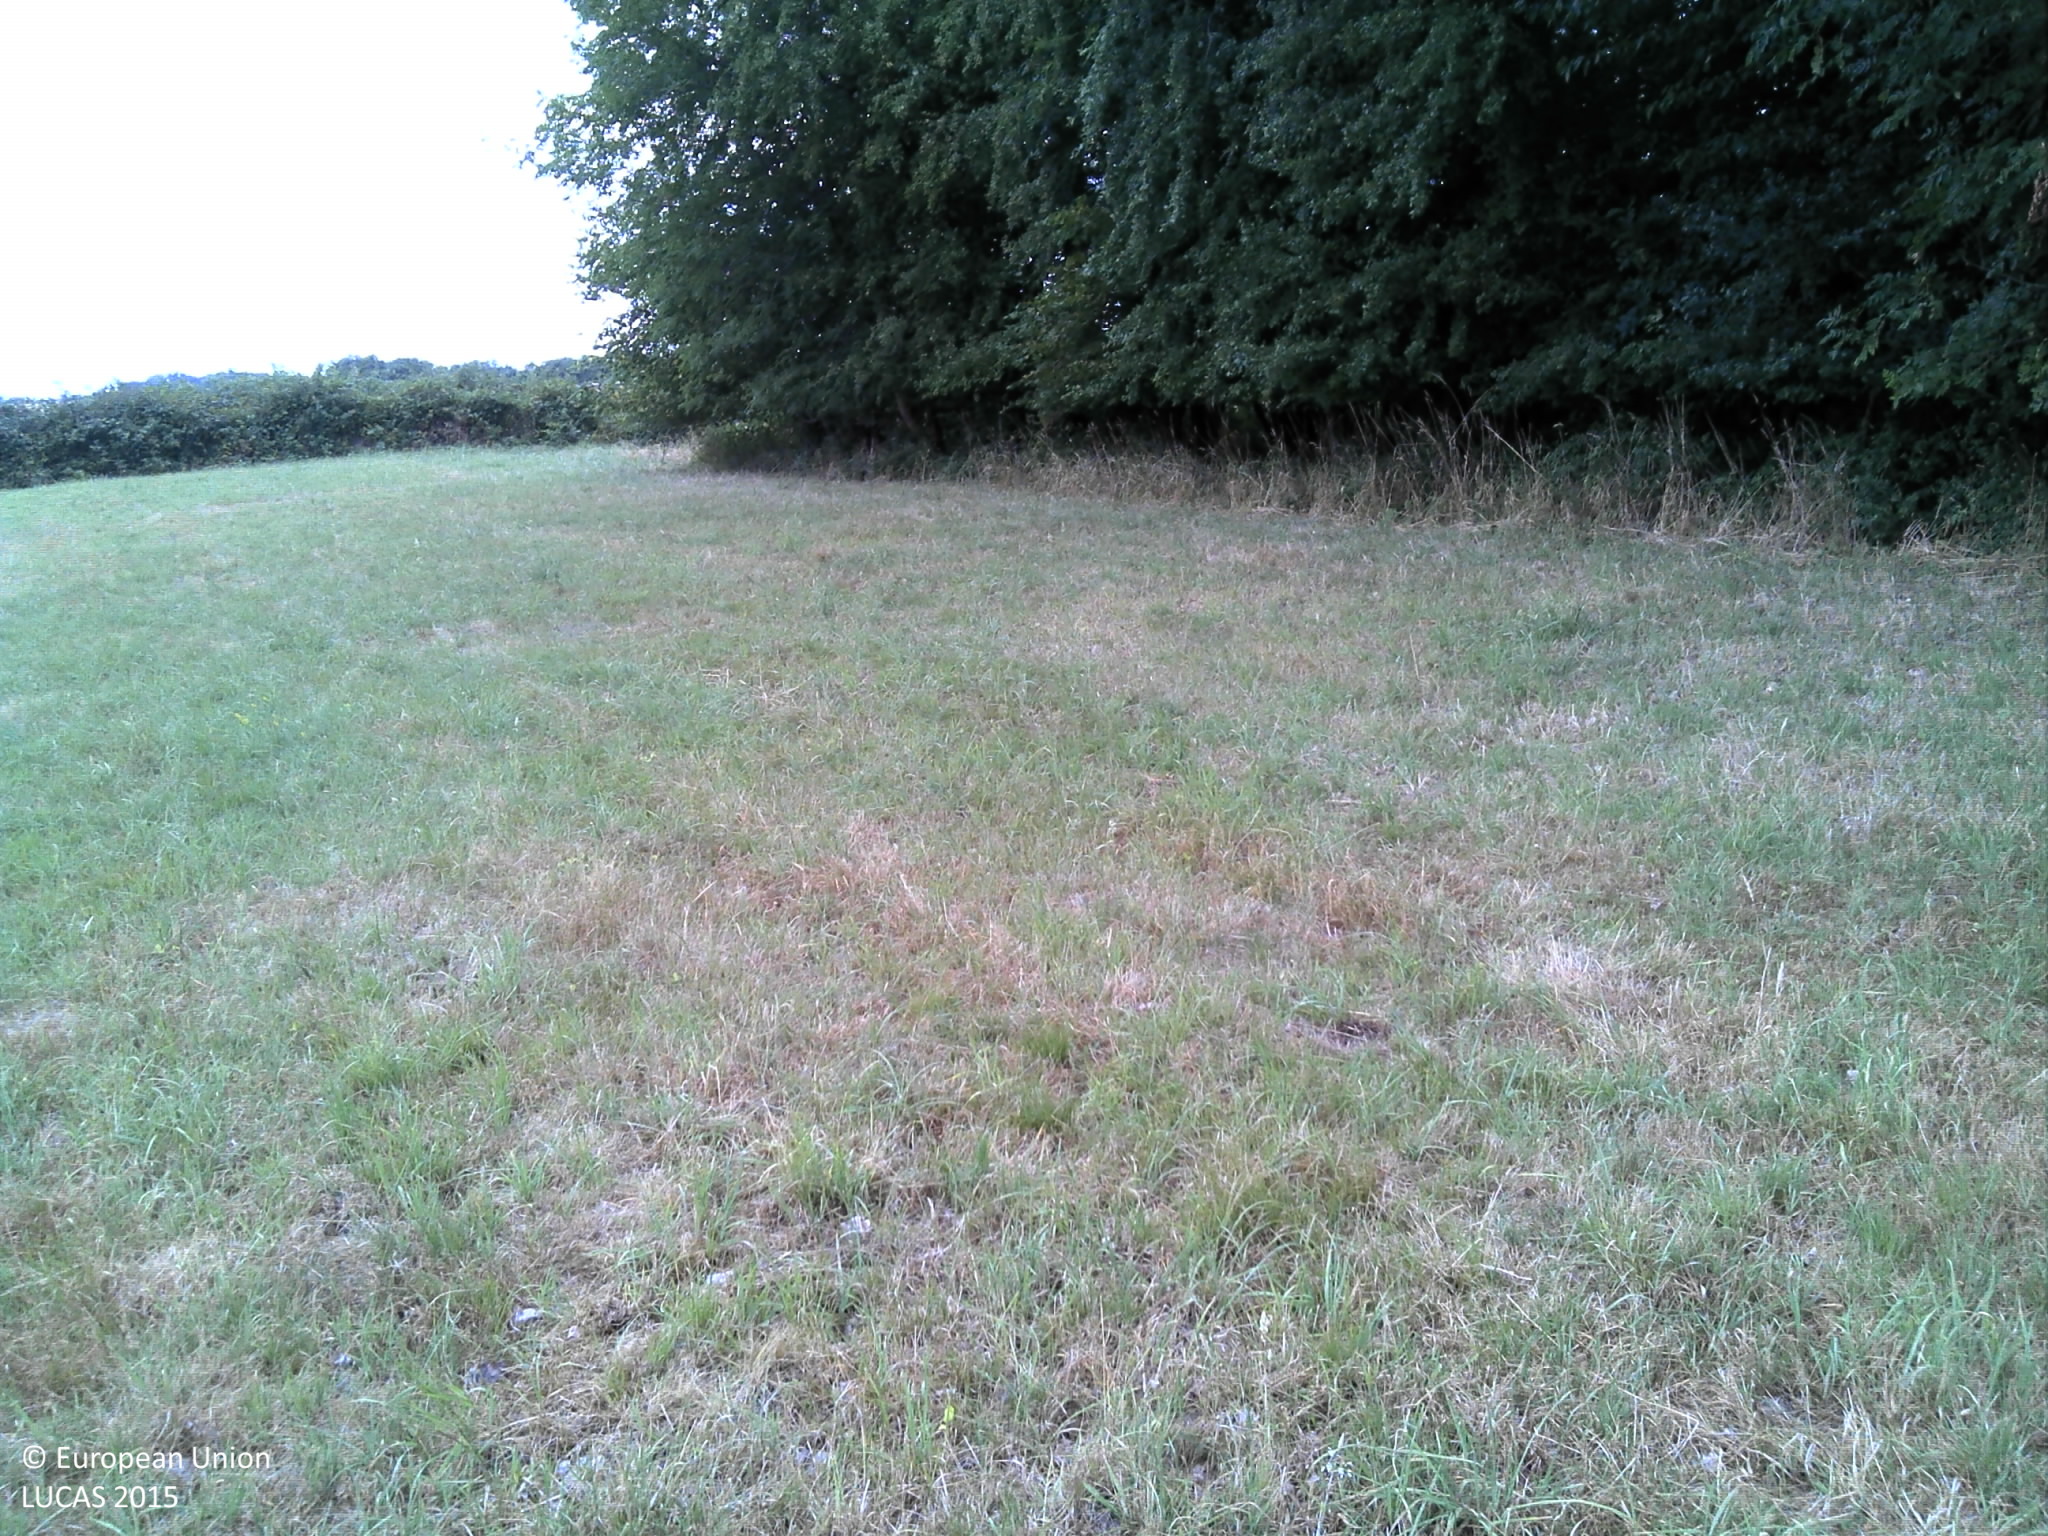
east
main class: Grassland
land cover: Grassland without tree/shrub cover
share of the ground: > 75 %
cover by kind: herbaceous plants 100 %
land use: Agriculture (excluding fallow land and kitchen gardens)
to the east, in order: Grassland without tree/shrub cover; Broadleaved woodland; Fences; Broadleaved woodland; Grassland without tree/shrub cover; Fences; Managed hedges; Tracks; Grass margins; Maize
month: July
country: FR
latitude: 48.5457
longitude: 4.6741
